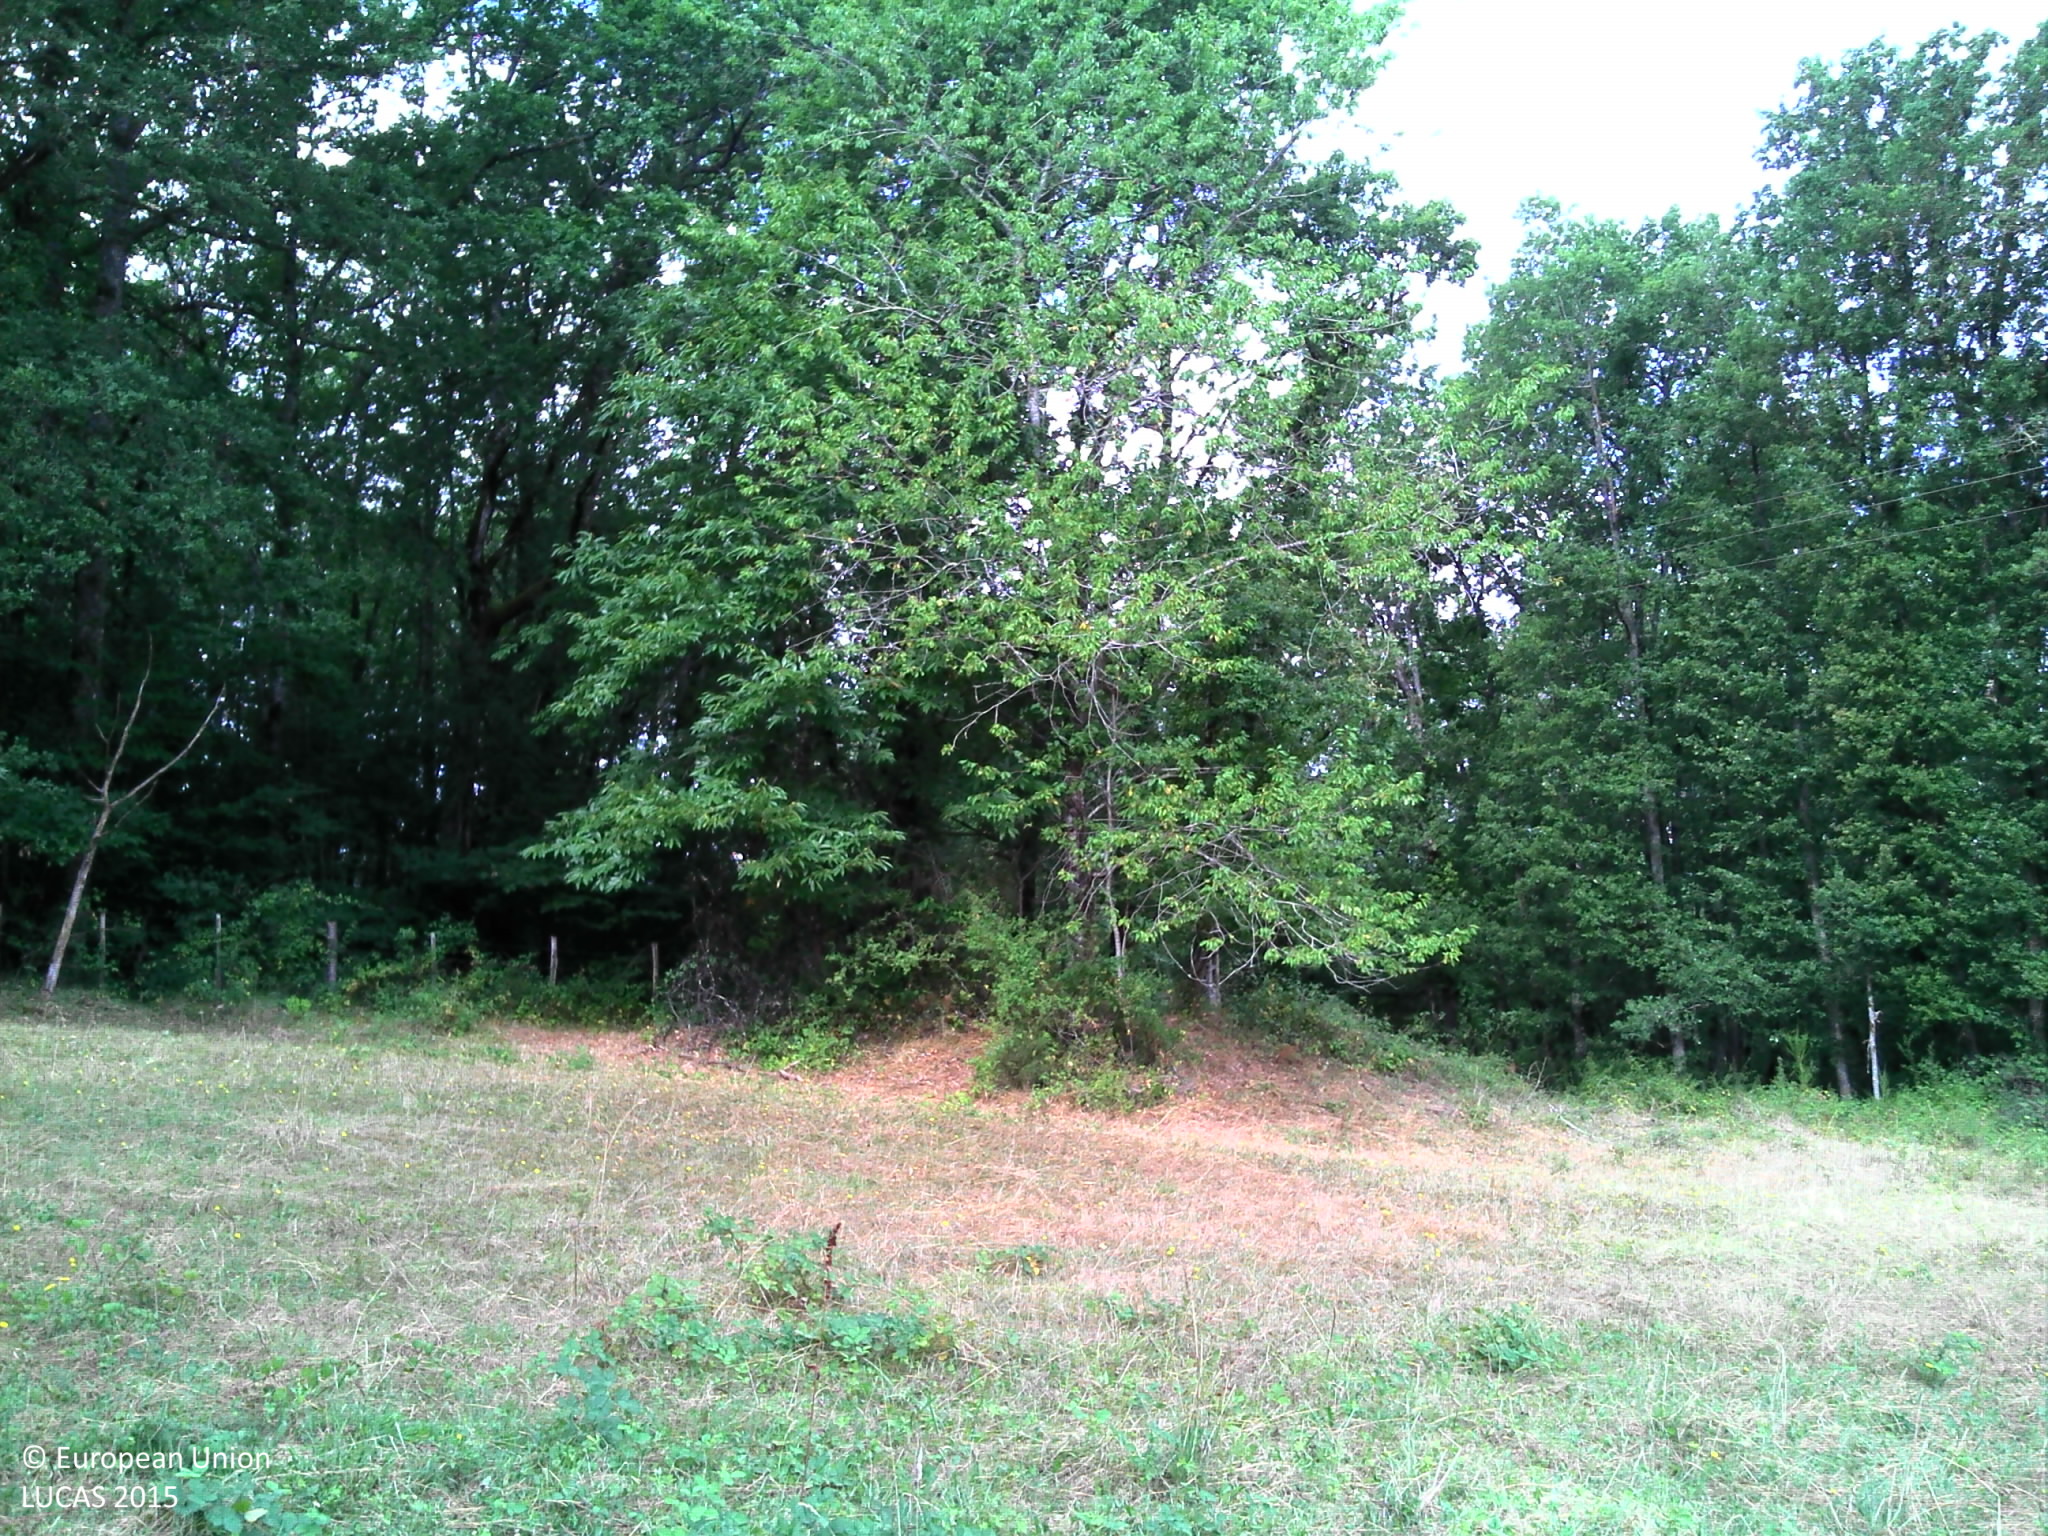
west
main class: Grassland
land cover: Grassland without tree/shrub cover
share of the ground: > 75 %
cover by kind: herbaceous plants 95 %, lichens and mosses 5 %
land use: Agriculture (excluding fallow land and kitchen gardens)
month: July
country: FR
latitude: 45.0217
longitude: 0.9185
